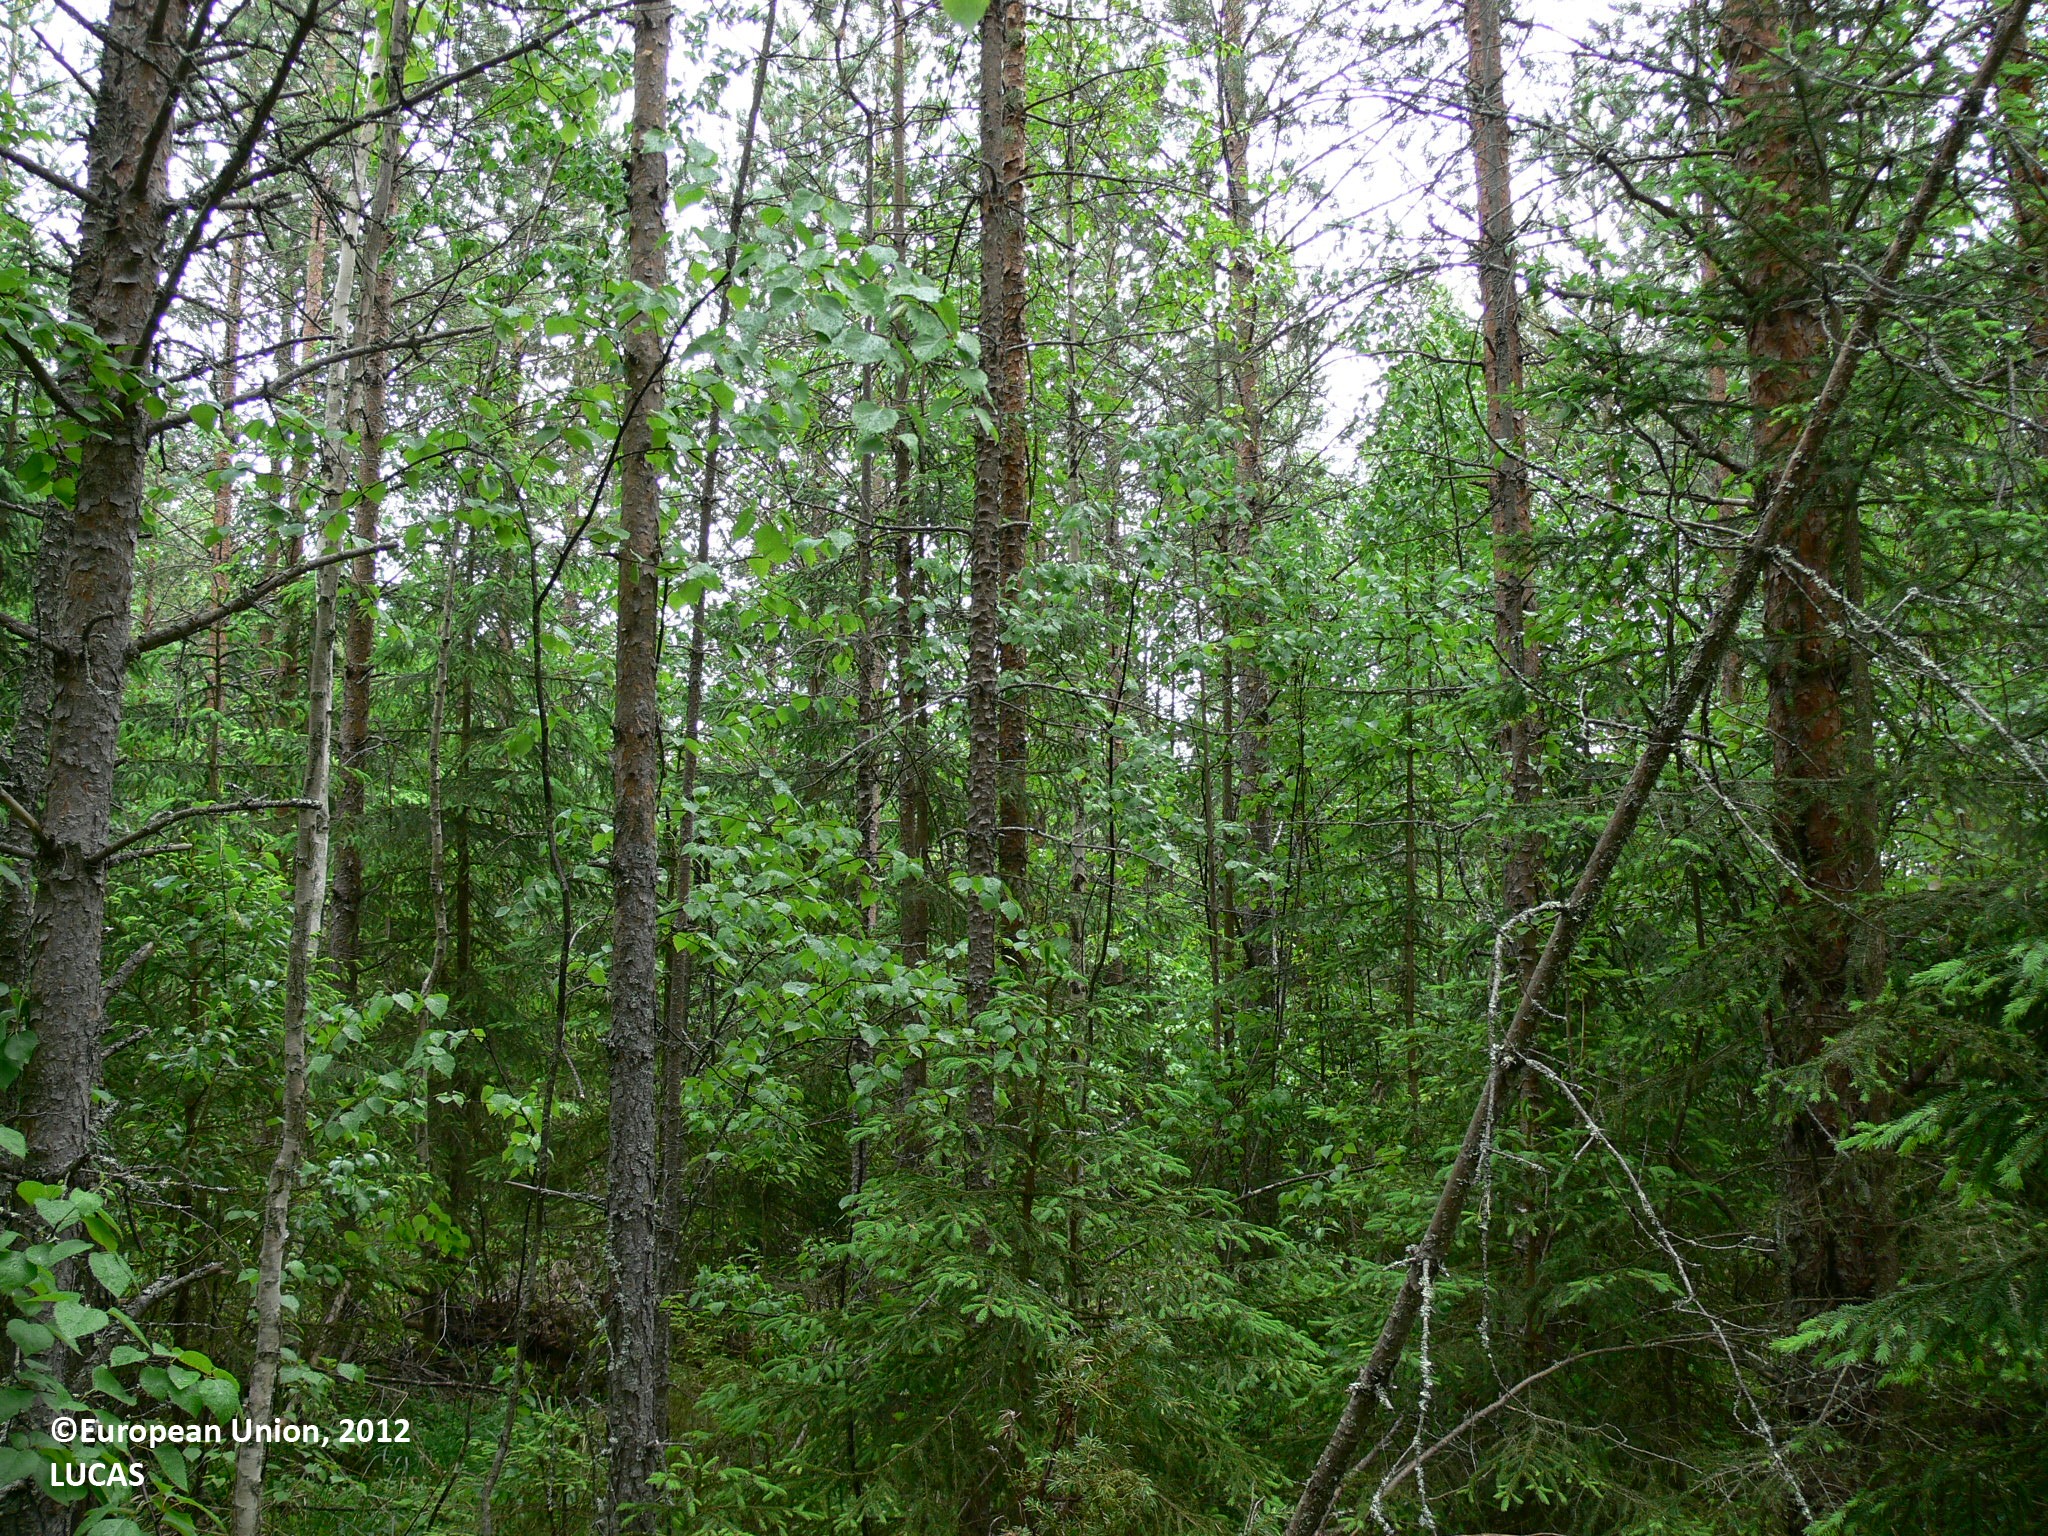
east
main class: Woodland
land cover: Pine dominated coniferous woodland
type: boreal forest
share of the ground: > 75 %
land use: Forestry
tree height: > 5 m
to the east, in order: Pine dominated coniferous woodland; Pine dominated mixed woodland; Ditches and canals; Grass margins; Paved roads, cycling and walking lanes; Grass margins; Pine dominated mixed woodland; Grassland without tree/shrub cover; Electric lines; Grassland without tree/shrub cover; Pine dominated mixed woodland; Tracks; Pine dominated mixed woodland; Pine dominated coniferous woodland; Ditches and canals; Other coniferous woodland
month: June
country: FI
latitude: 62.9319
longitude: 29.7247
